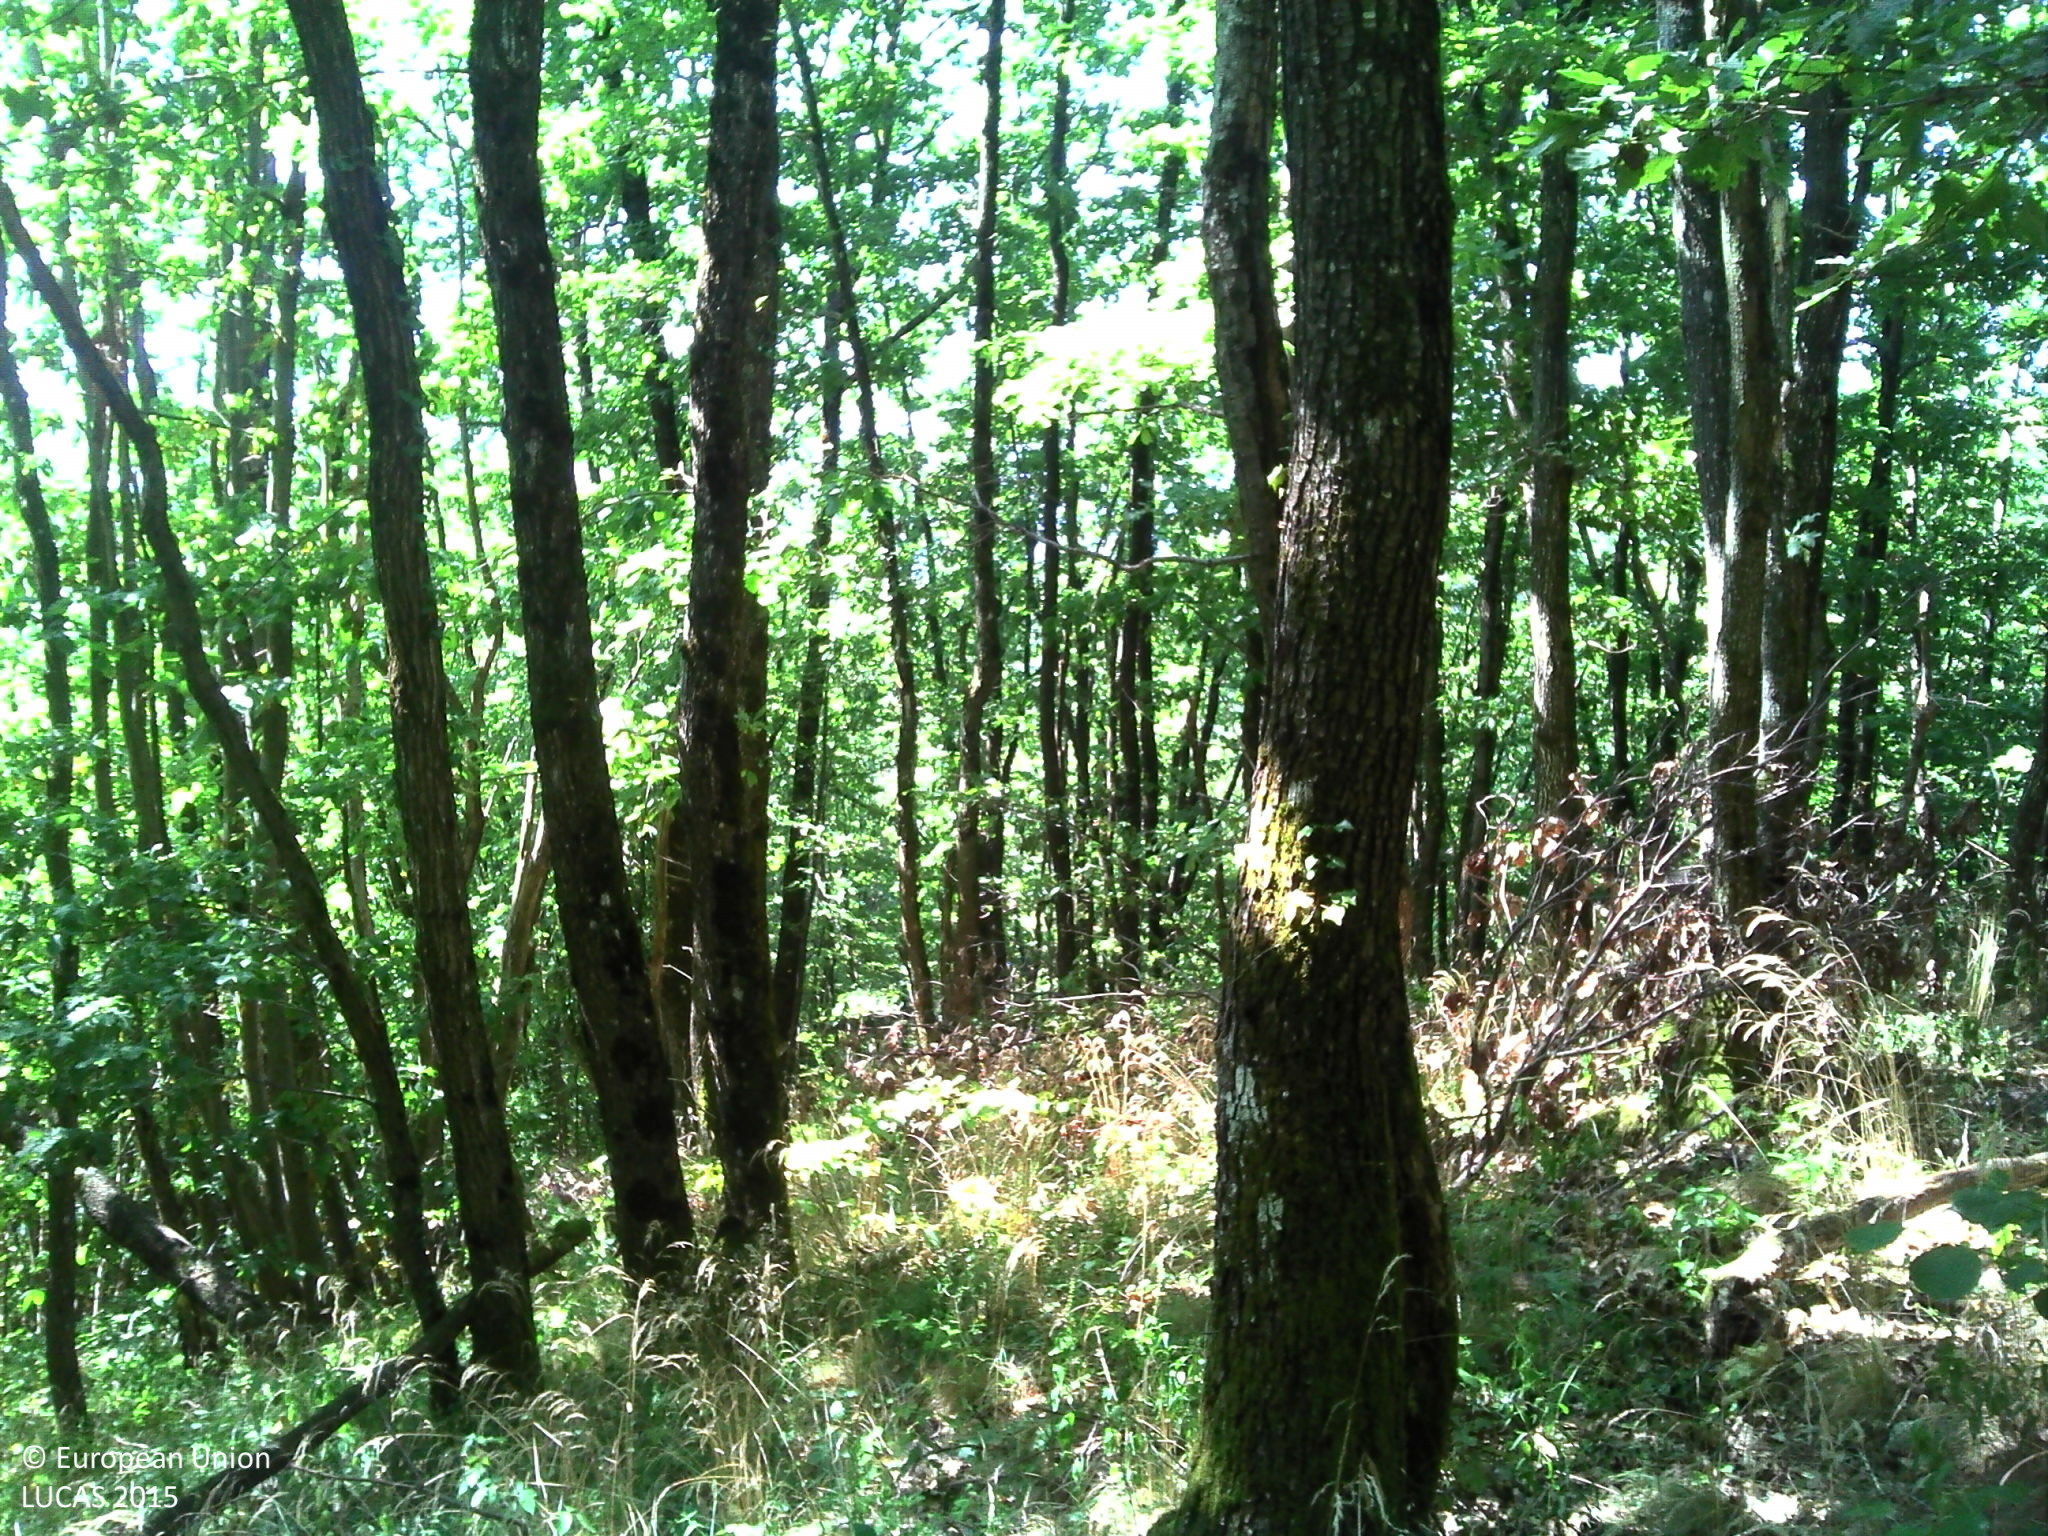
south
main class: Woodland
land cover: Broadleaved woodland
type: mesophytic deciduous forest
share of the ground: > 75 %
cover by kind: broadleaved forest trees 90 %, herbaceous plants 5 %, unconsolidated bare surface 5 %
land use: Forestry
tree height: > 5 m
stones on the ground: 10 - 25 %
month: July
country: FR
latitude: 45.3173
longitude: 5.4765
